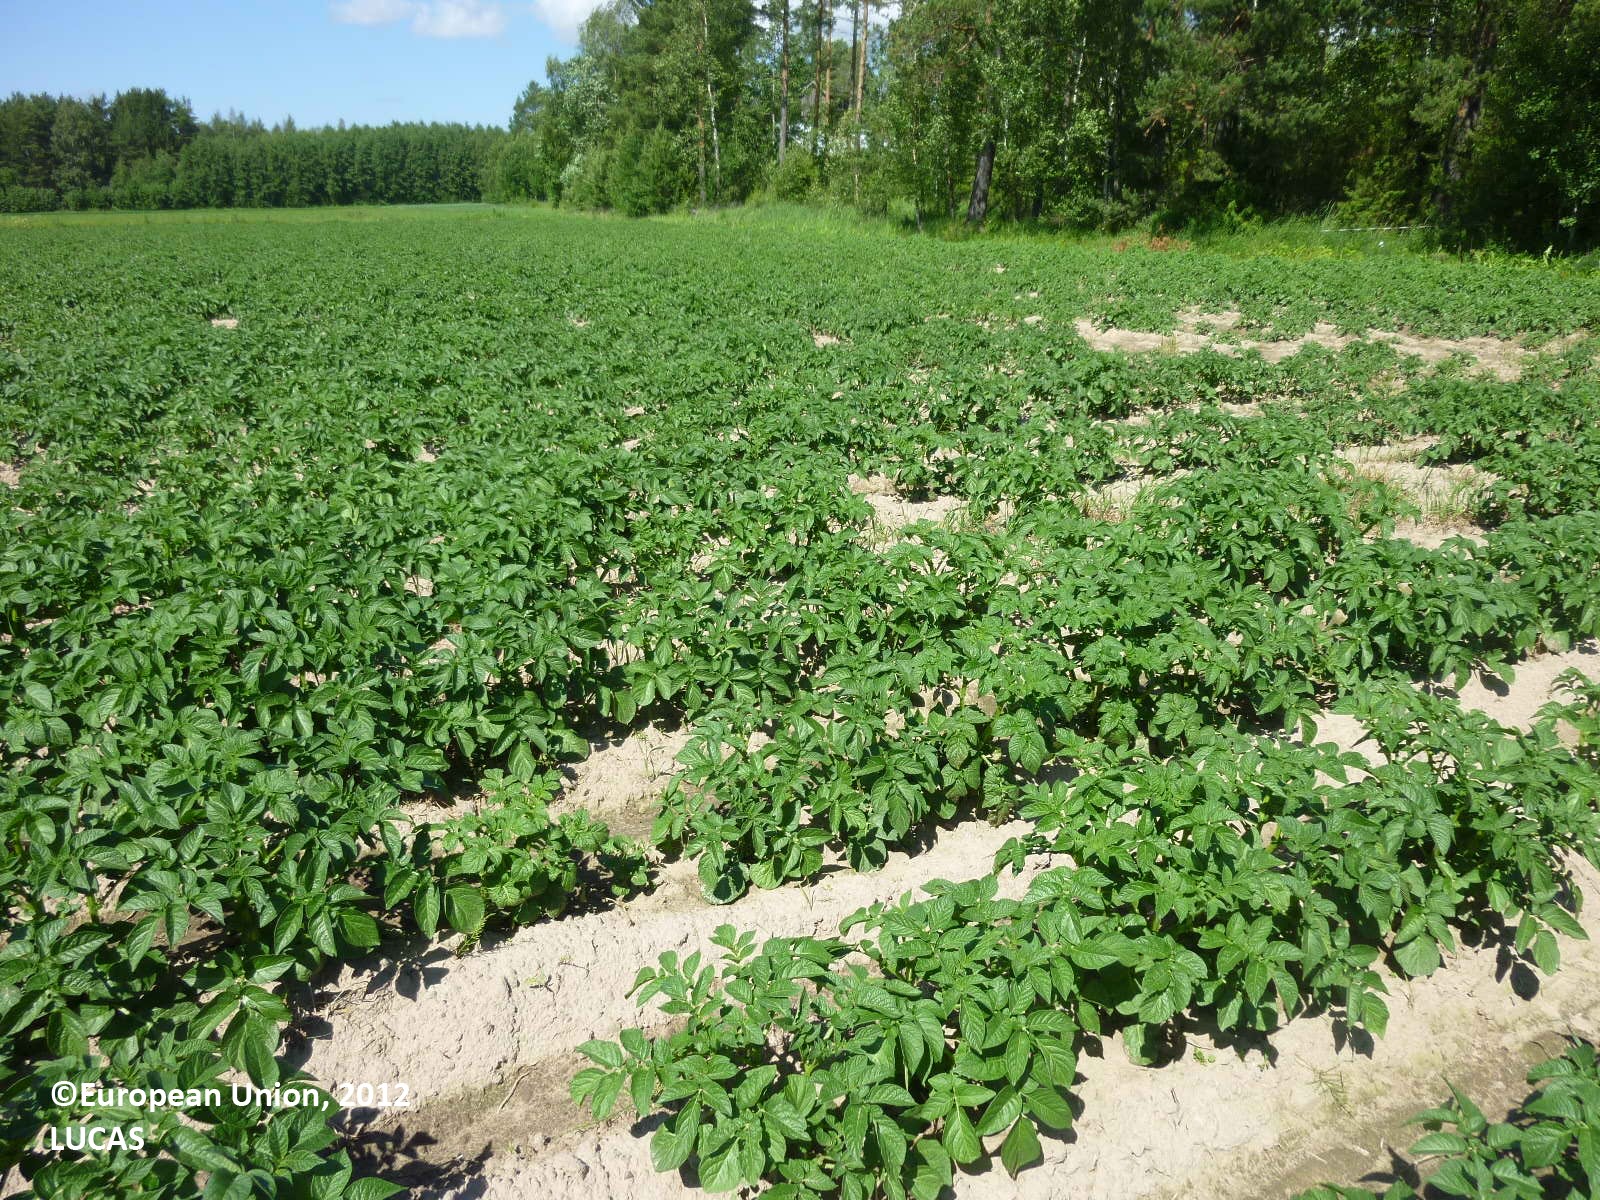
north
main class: Cropland
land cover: Potatoes
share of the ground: 25 - 50 %
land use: Agriculture (excluding fallow land and kitchen gardens)
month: July
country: FI
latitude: 61.3772
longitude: 22.0532
